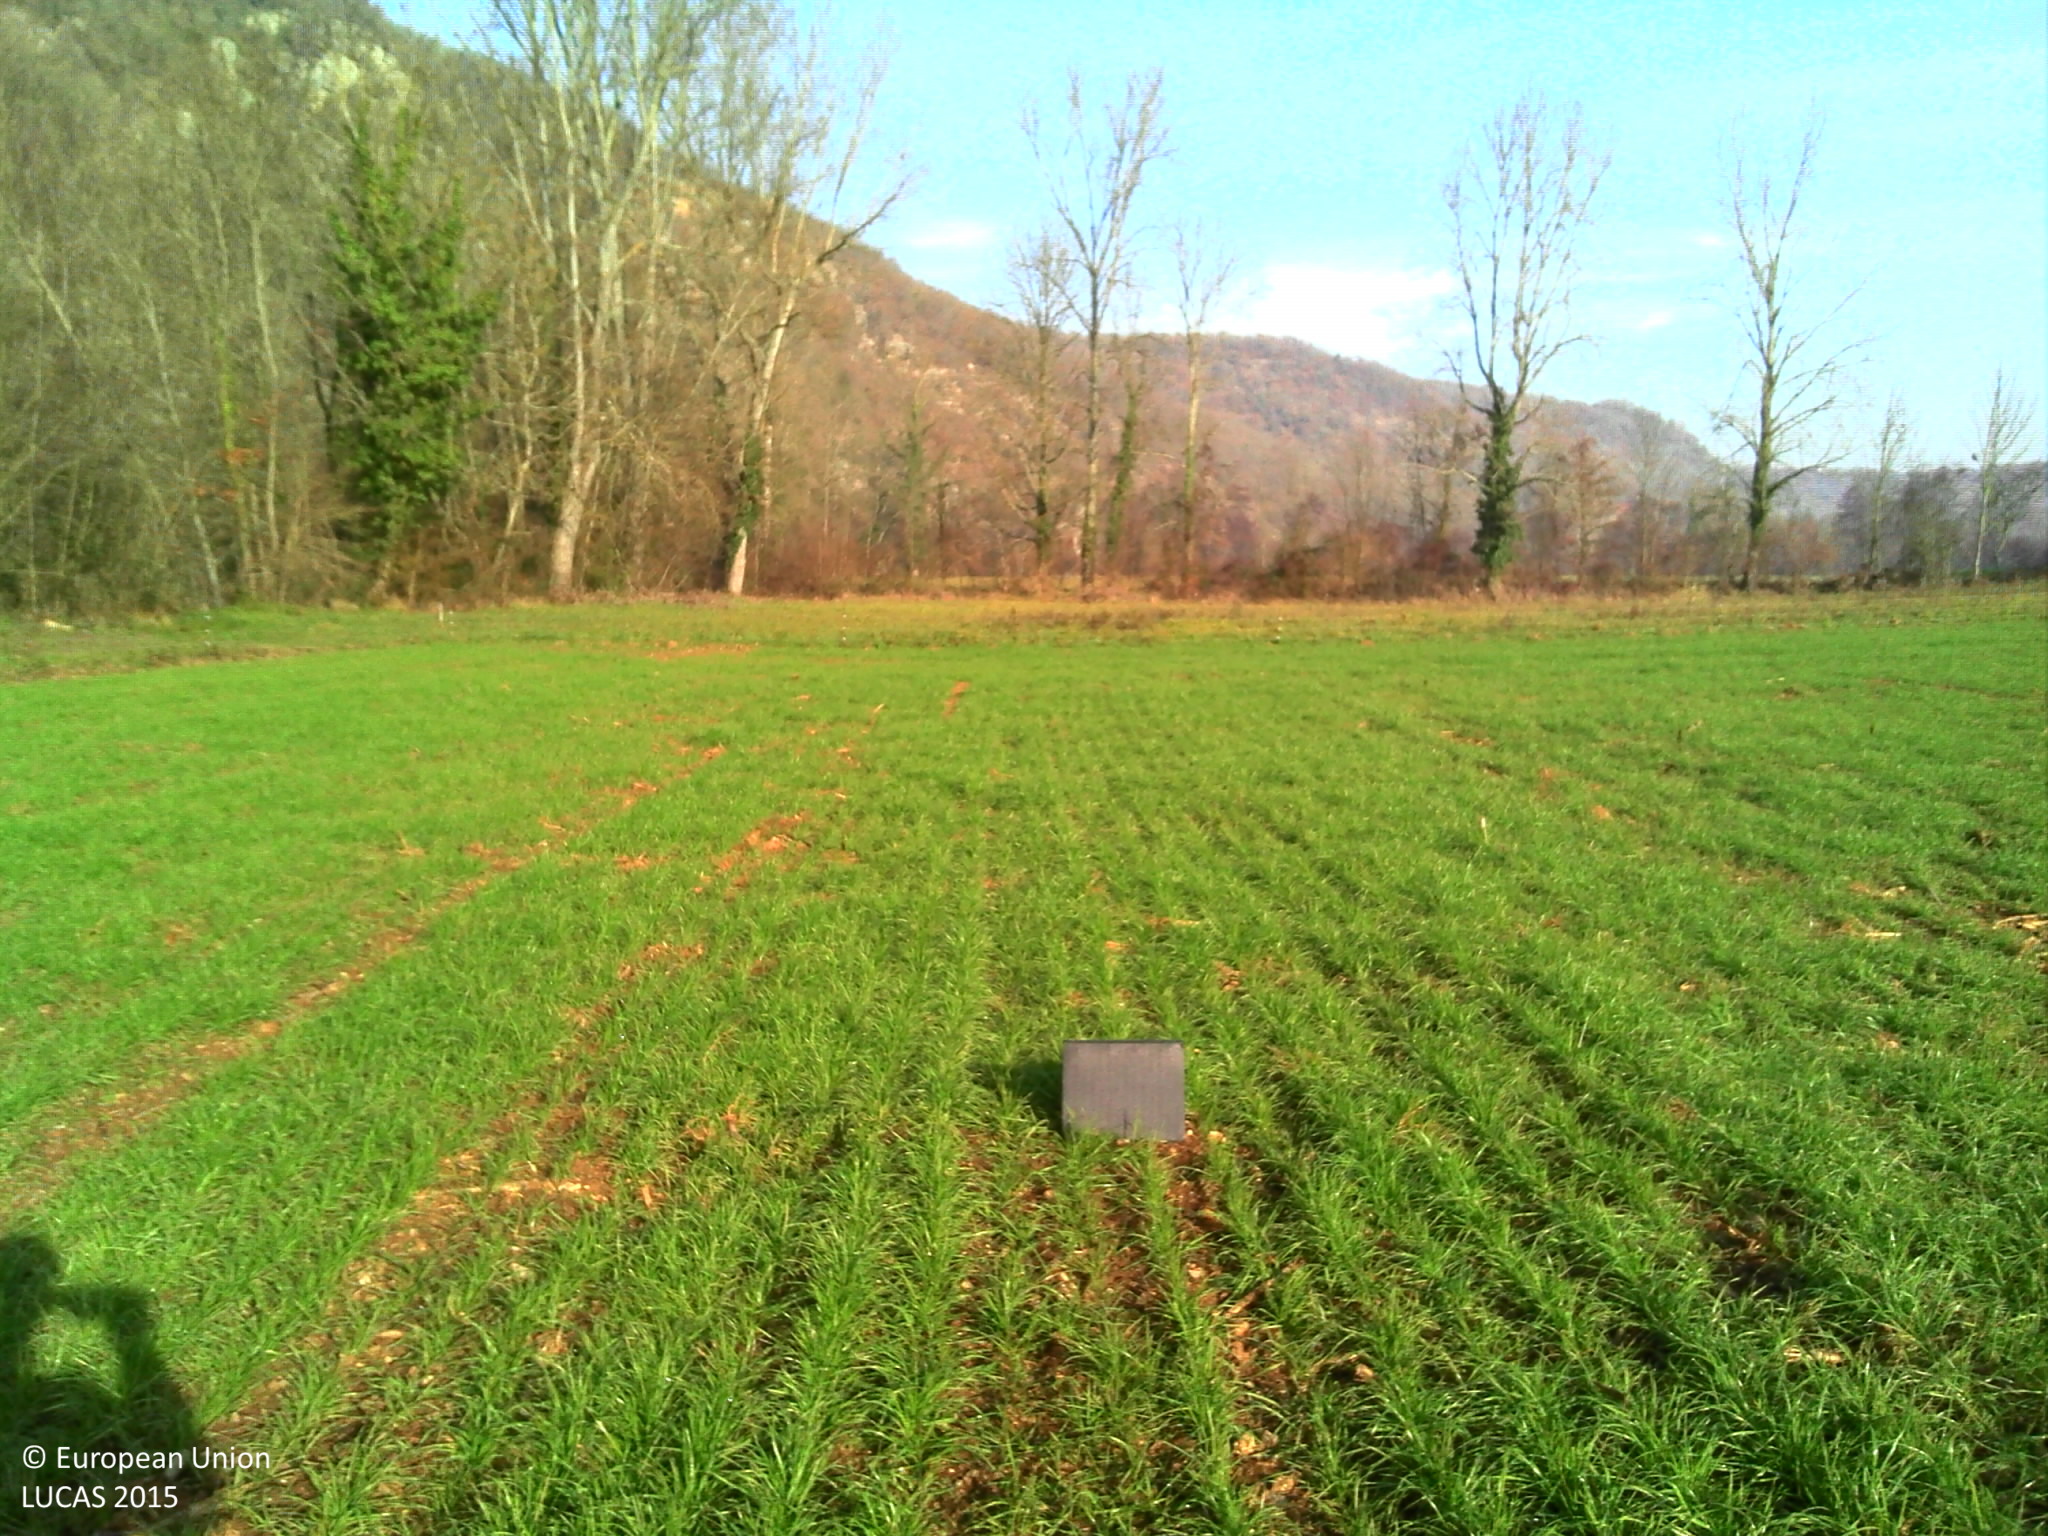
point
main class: Cropland
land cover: Maize
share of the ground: 50 - 75 %
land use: Agriculture (excluding fallow land and kitchen gardens)
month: December
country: FR
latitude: 44.5932
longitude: 1.8745
